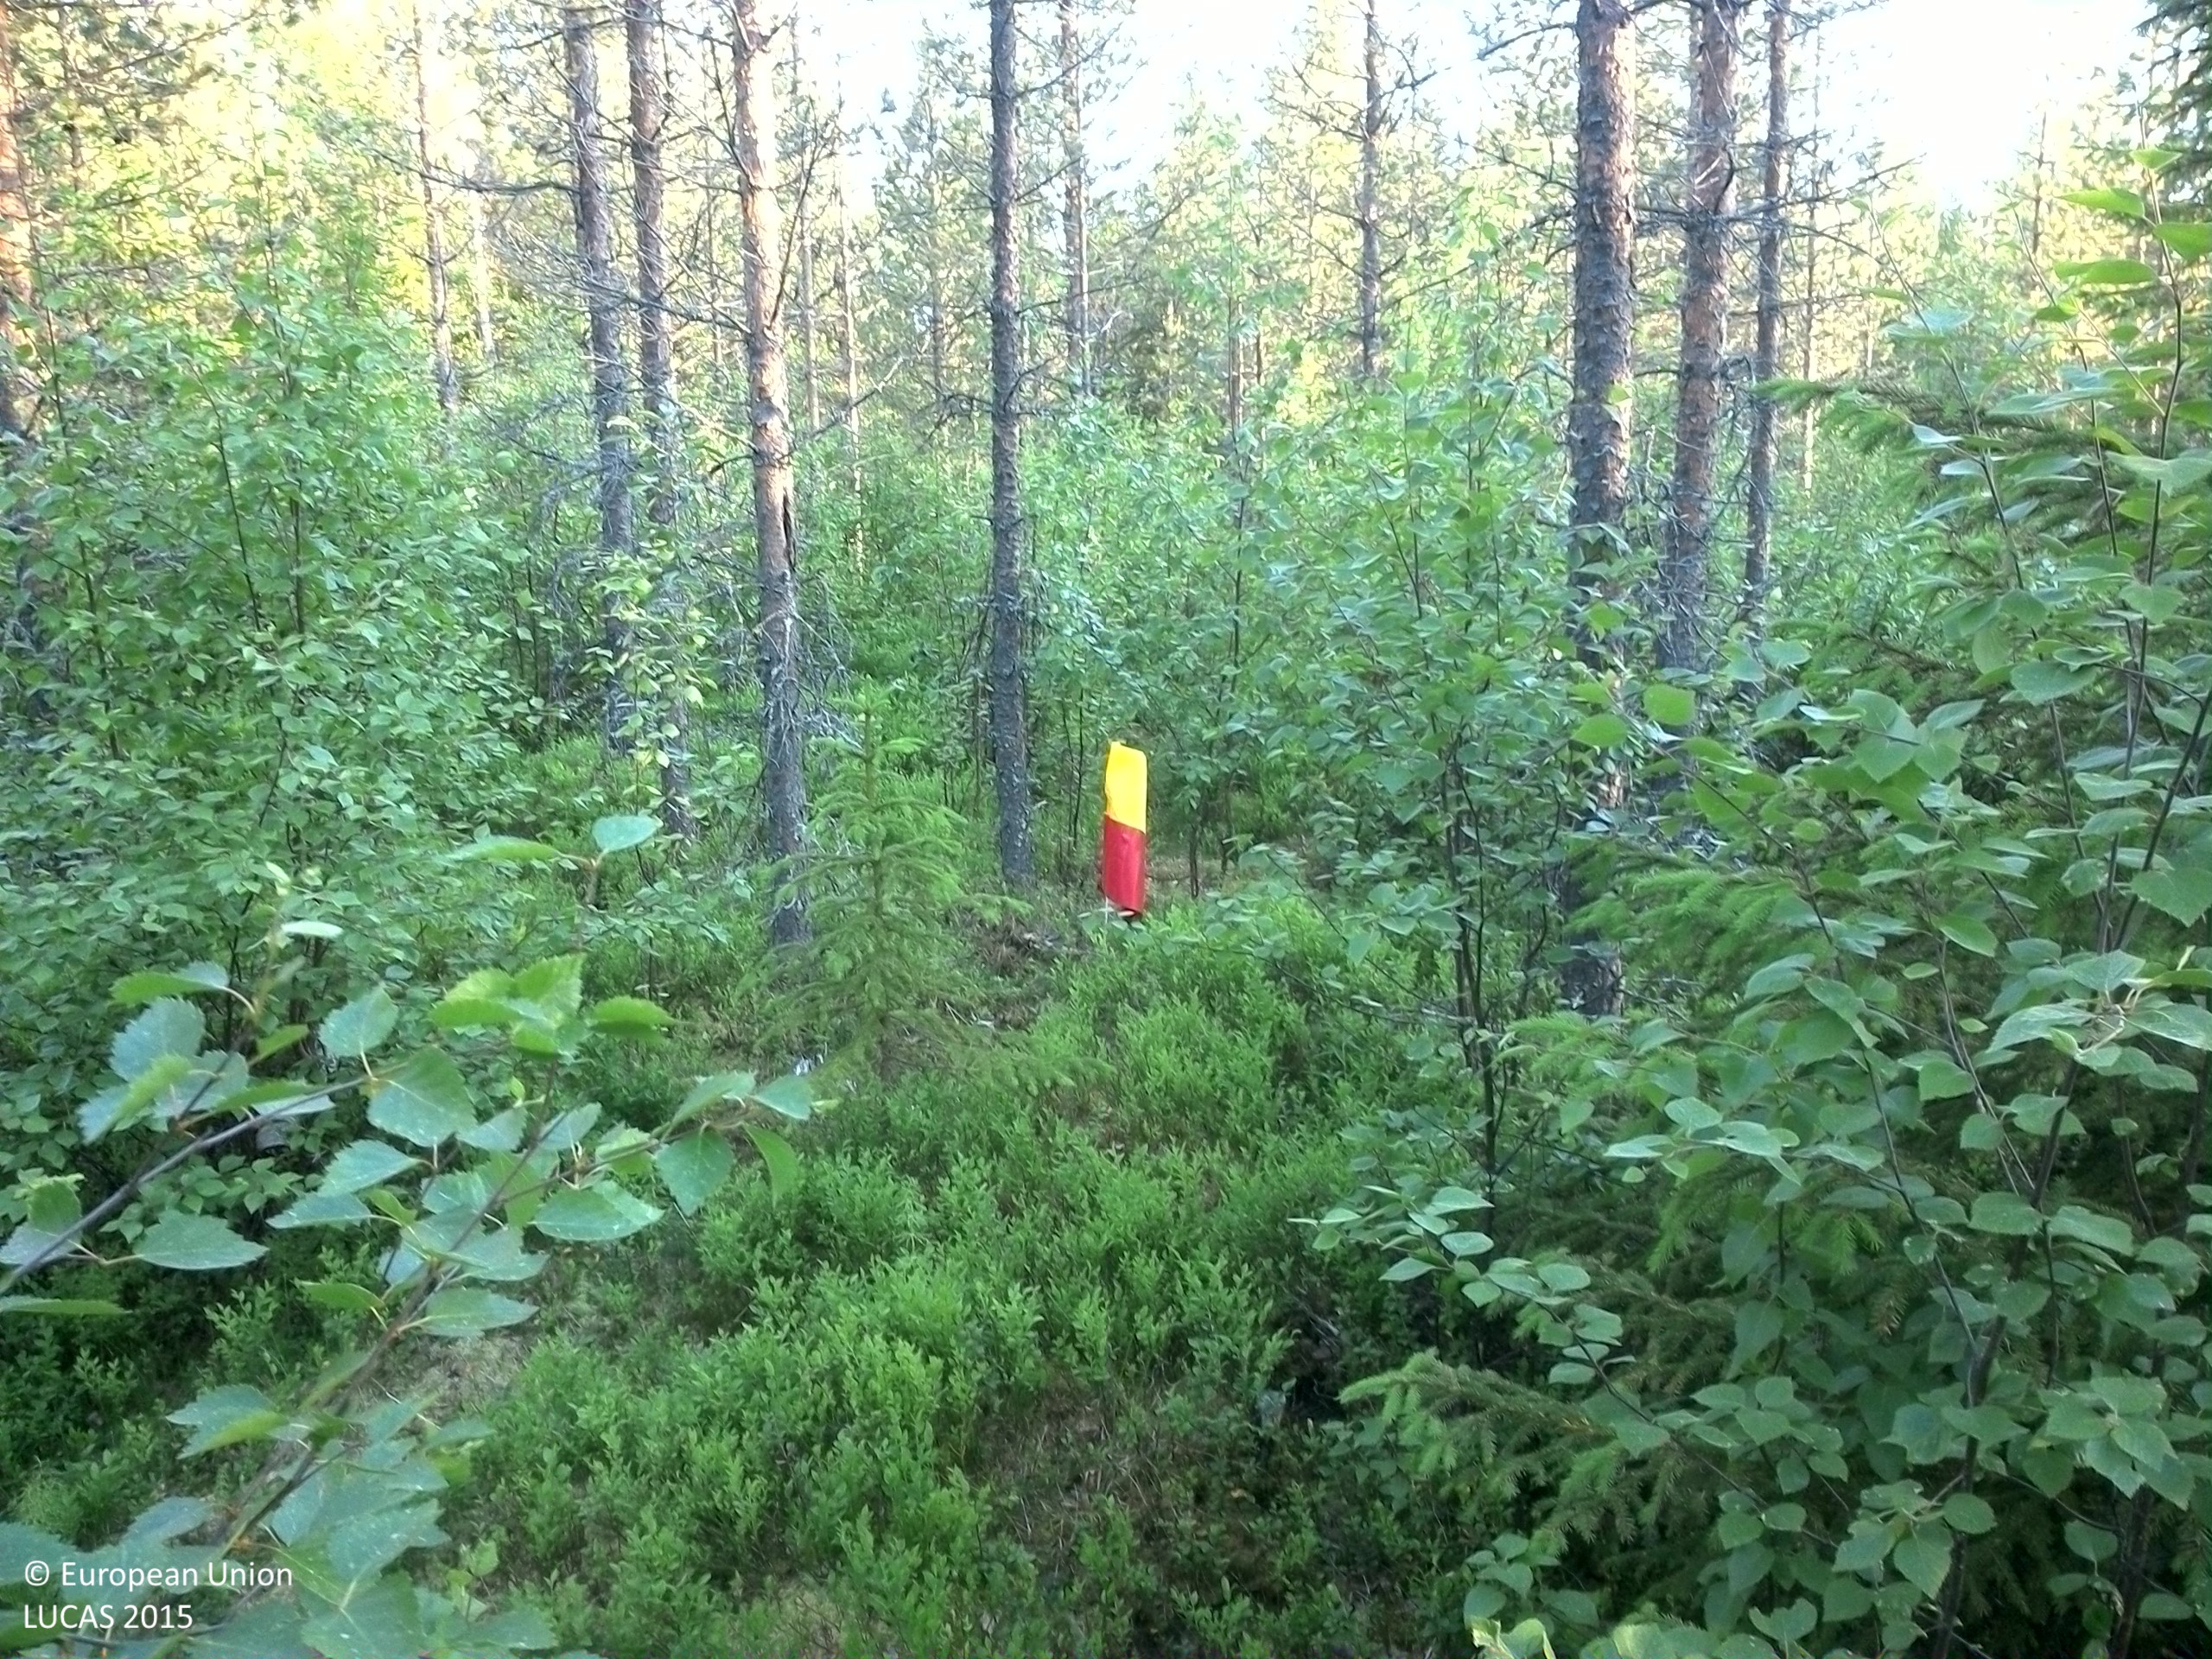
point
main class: Woodland
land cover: Pine dominated mixed woodland
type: boreal forest
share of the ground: > 75 %
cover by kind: coniferous forest trees 50 %, broadleaved forest trees 30 %, shrubs 15 %, lichens and mosses 5 %
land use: Forestry
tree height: < 5 m
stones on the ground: 25 - 50 %
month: July
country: SE
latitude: 64.2830
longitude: 16.9295
